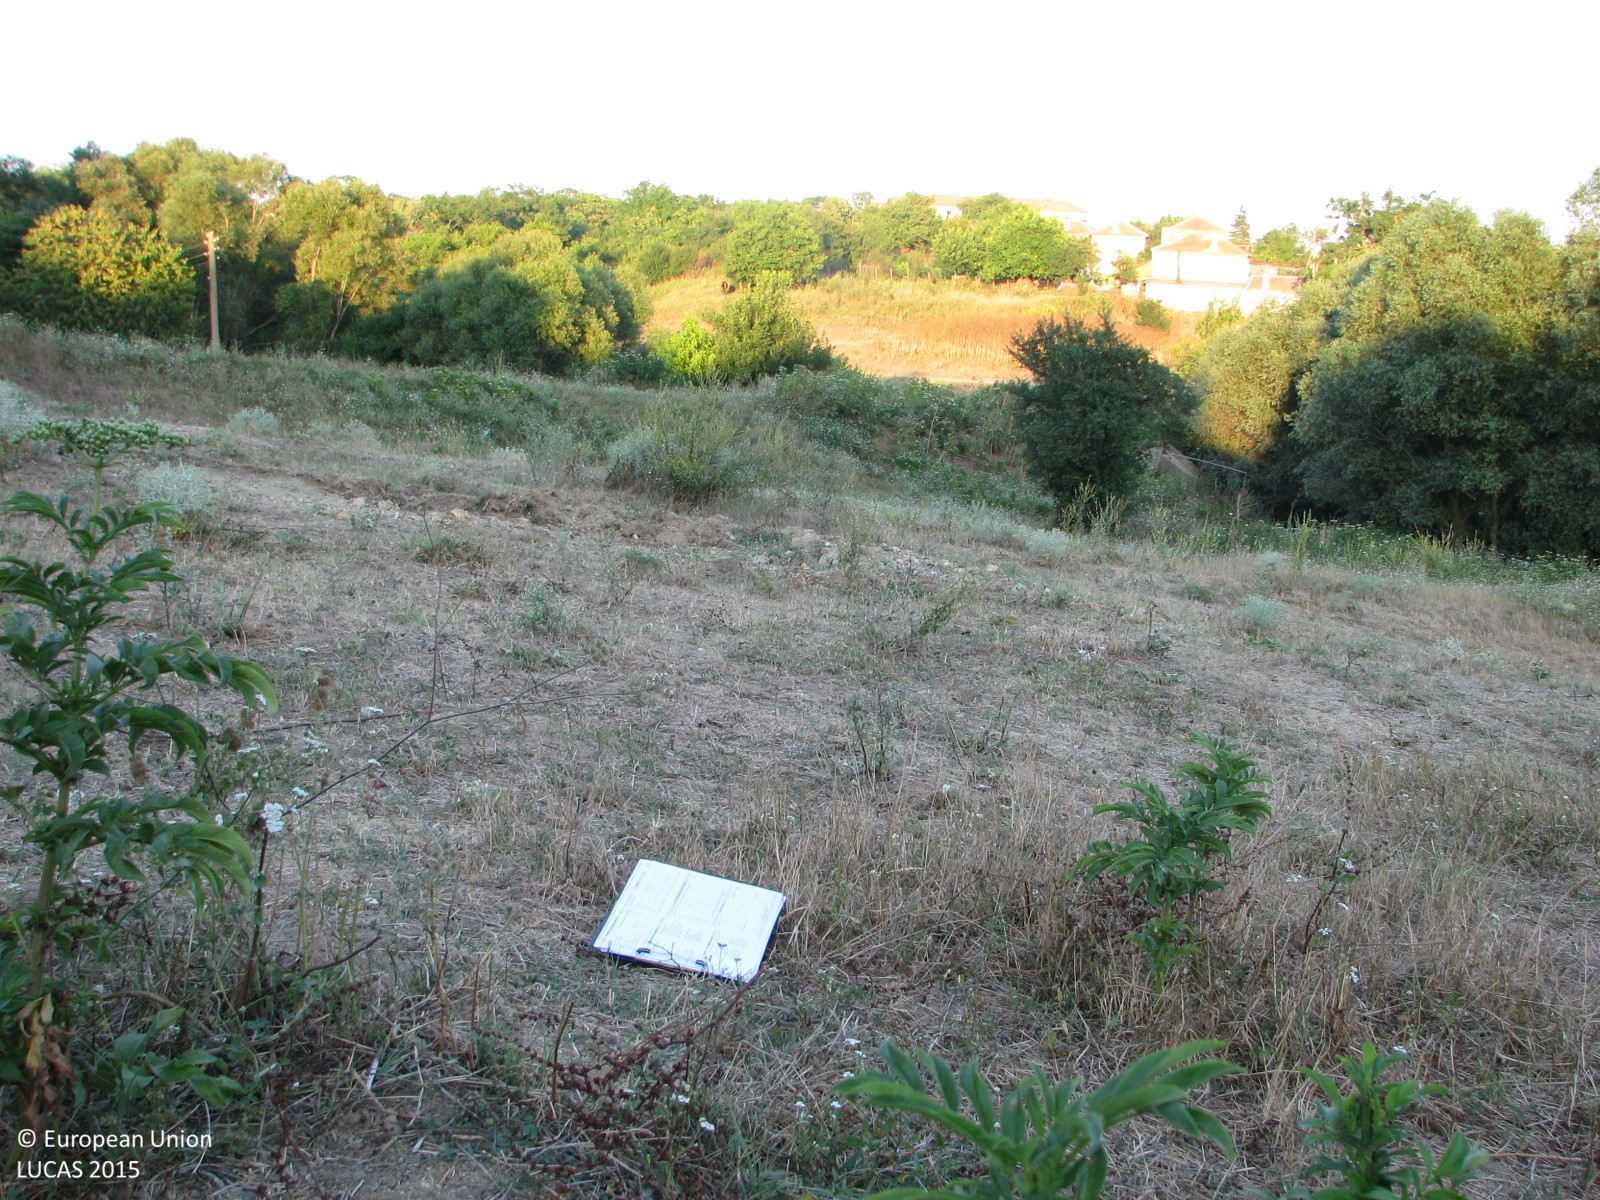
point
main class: Grassland
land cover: Grassland without tree/shrub cover
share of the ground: > 75 %
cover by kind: herbaceous plants 80 %, unconsolidated bare surface 20 %
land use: Agriculture (excluding fallow land and kitchen gardens)
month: July
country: BG
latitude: 42.1943
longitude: 26.9188
